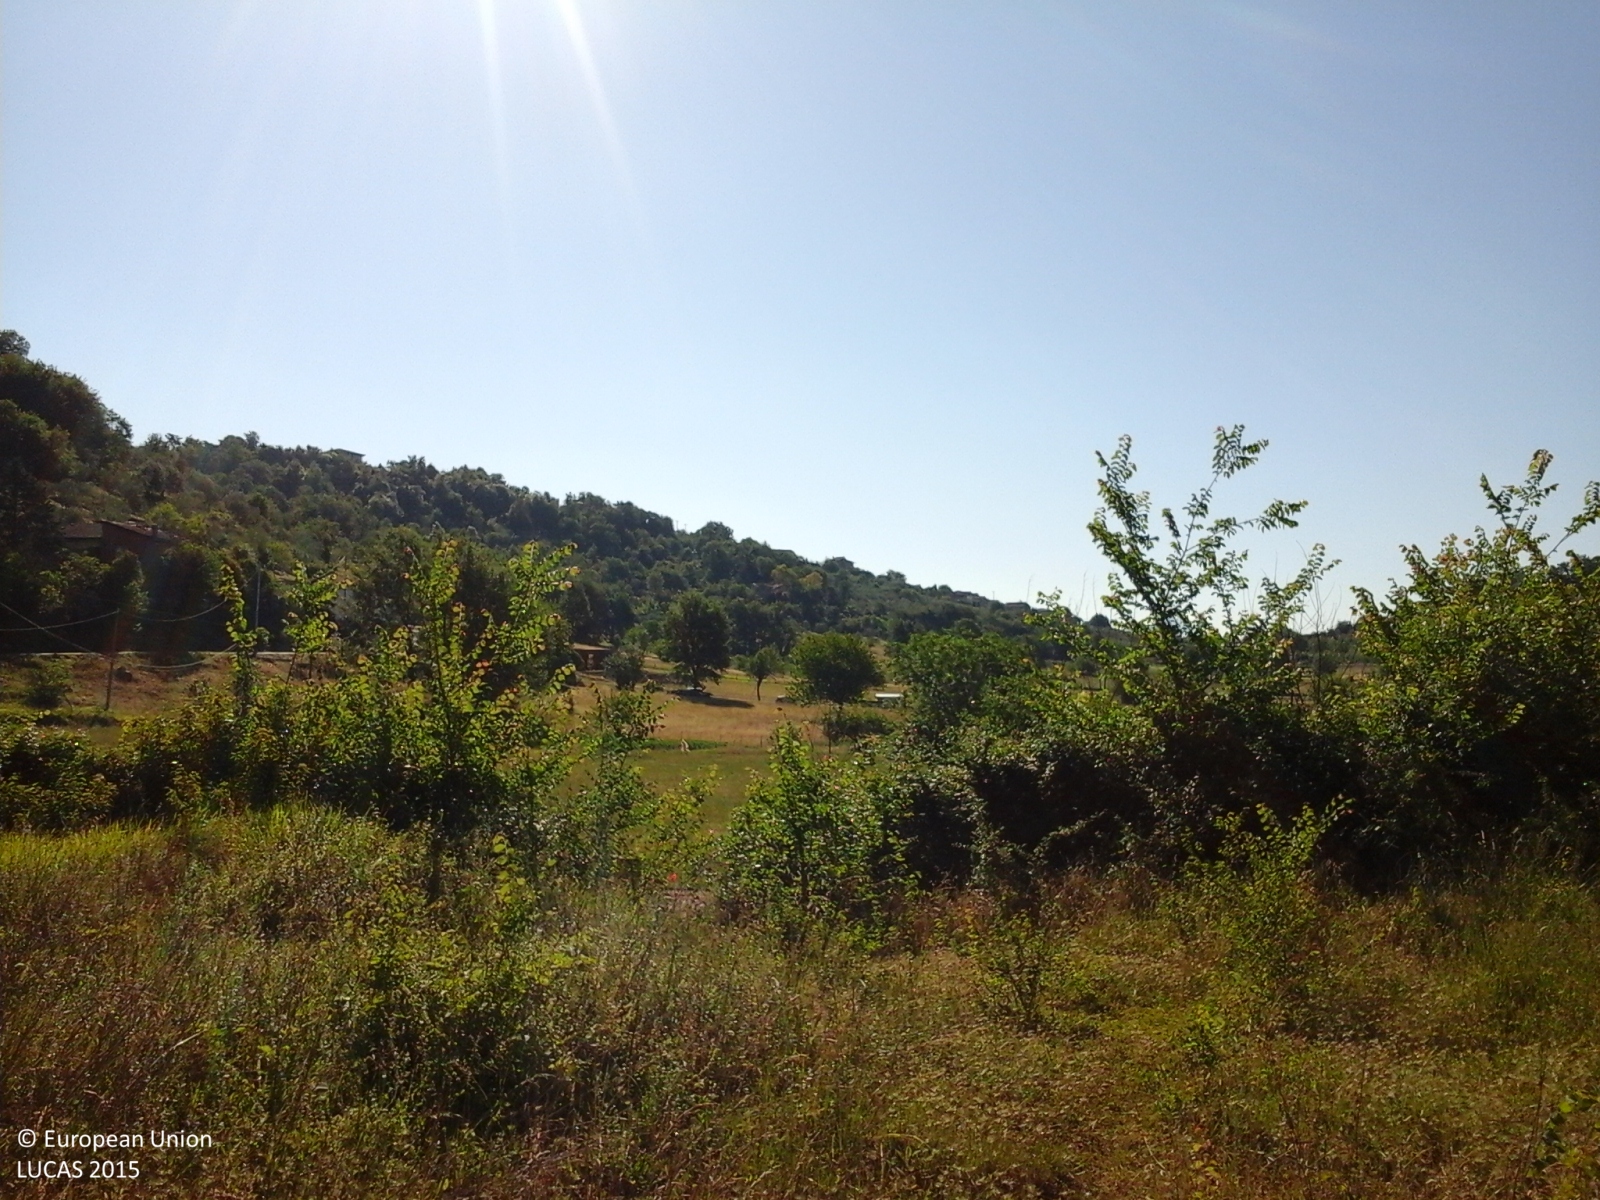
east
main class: Grassland
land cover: Grassland without tree/shrub cover
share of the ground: 50 - 75 %
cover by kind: herbaceous plants 70 %, unconsolidated bare surface 30 %
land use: Abandoned areas
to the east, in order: Grassland without tree/shrub cover; Electric lines; Managed hedges; Grass margins; Paved roads, cycling and walking lanes; Grass margins; Grassland with sparse tree/shrub cover; Ditches and canals; Grass margins; Paved roads, cycling and walking lanes; Grass margins; Grassland without tree/shrub cover; Electric lines; Single bushes/trees; Fences; Grassland with sparse tree/shrub cover; Artificial constructions in urban areas; Grassland without tree/shrub cover
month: May
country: IT
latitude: 41.6744
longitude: 13.4106
